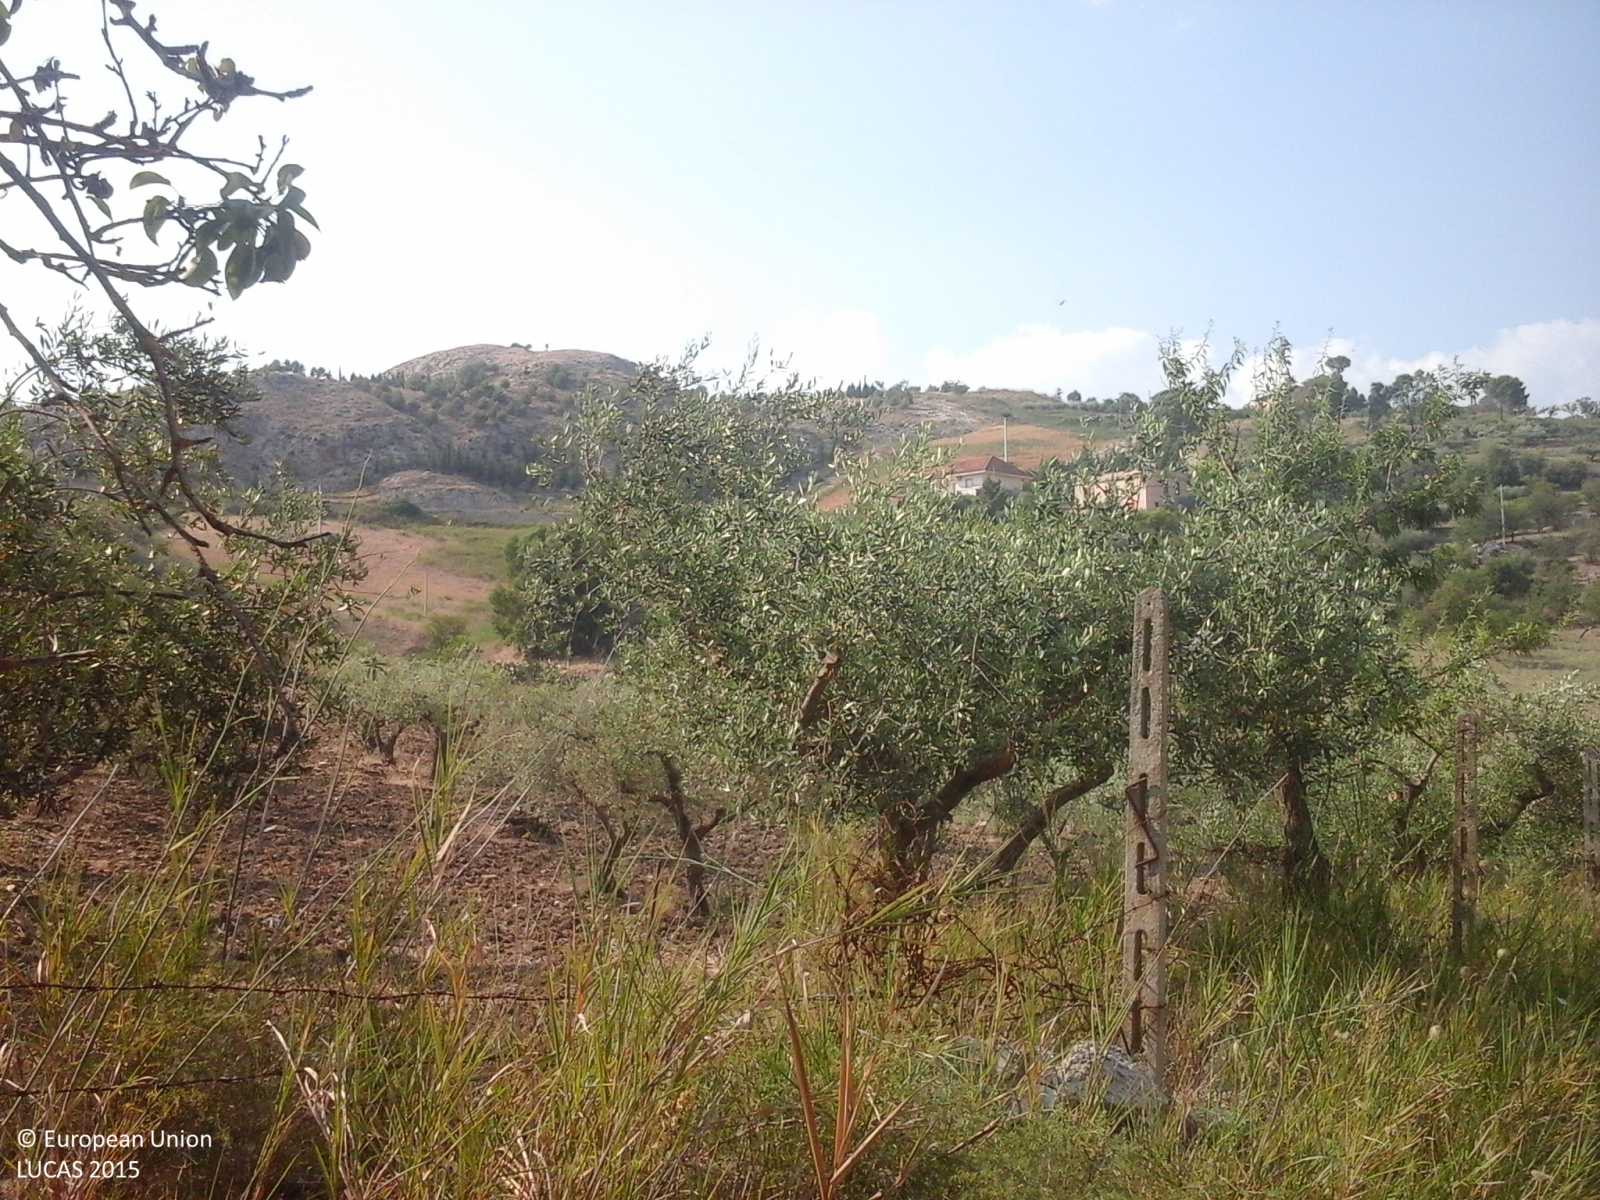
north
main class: Cropland
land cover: Durum wheat
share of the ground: > 75 %
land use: Agriculture (excluding fallow land and kitchen gardens)
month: July
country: IT
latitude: 37.4630
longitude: 13.5568
